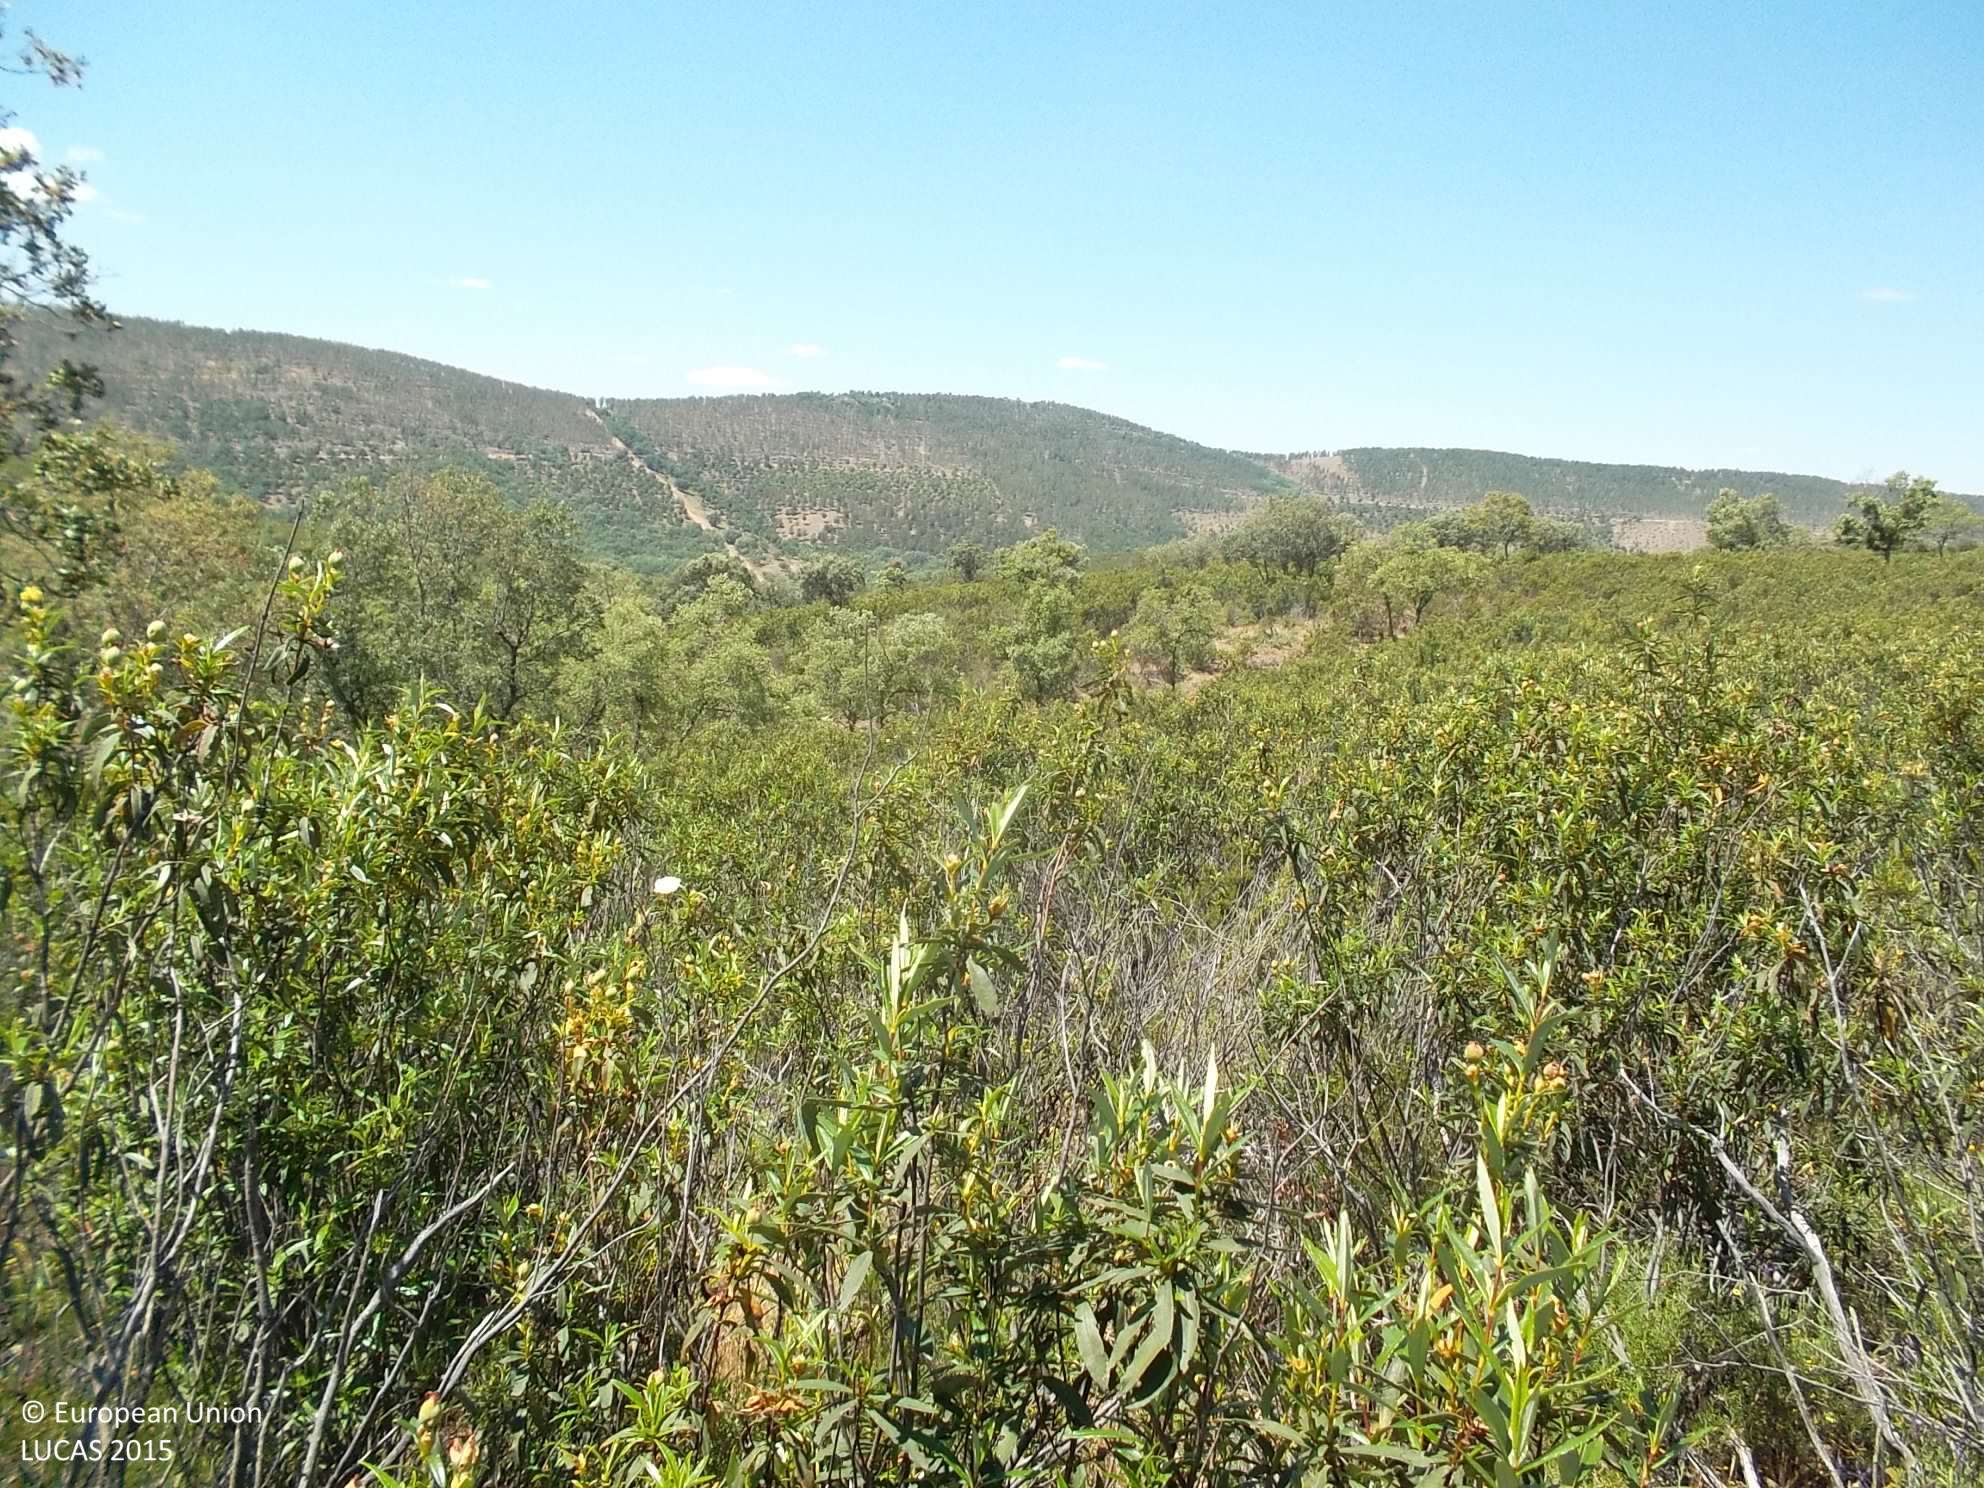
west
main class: Shrubland
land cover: Shrubland with sparse tree cover
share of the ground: > 75 %
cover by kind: shrubs 95 %, broadleaved forest trees 5 %
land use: Forestry
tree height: < 5 m
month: May
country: ES
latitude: 38.5211
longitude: -4.3910
